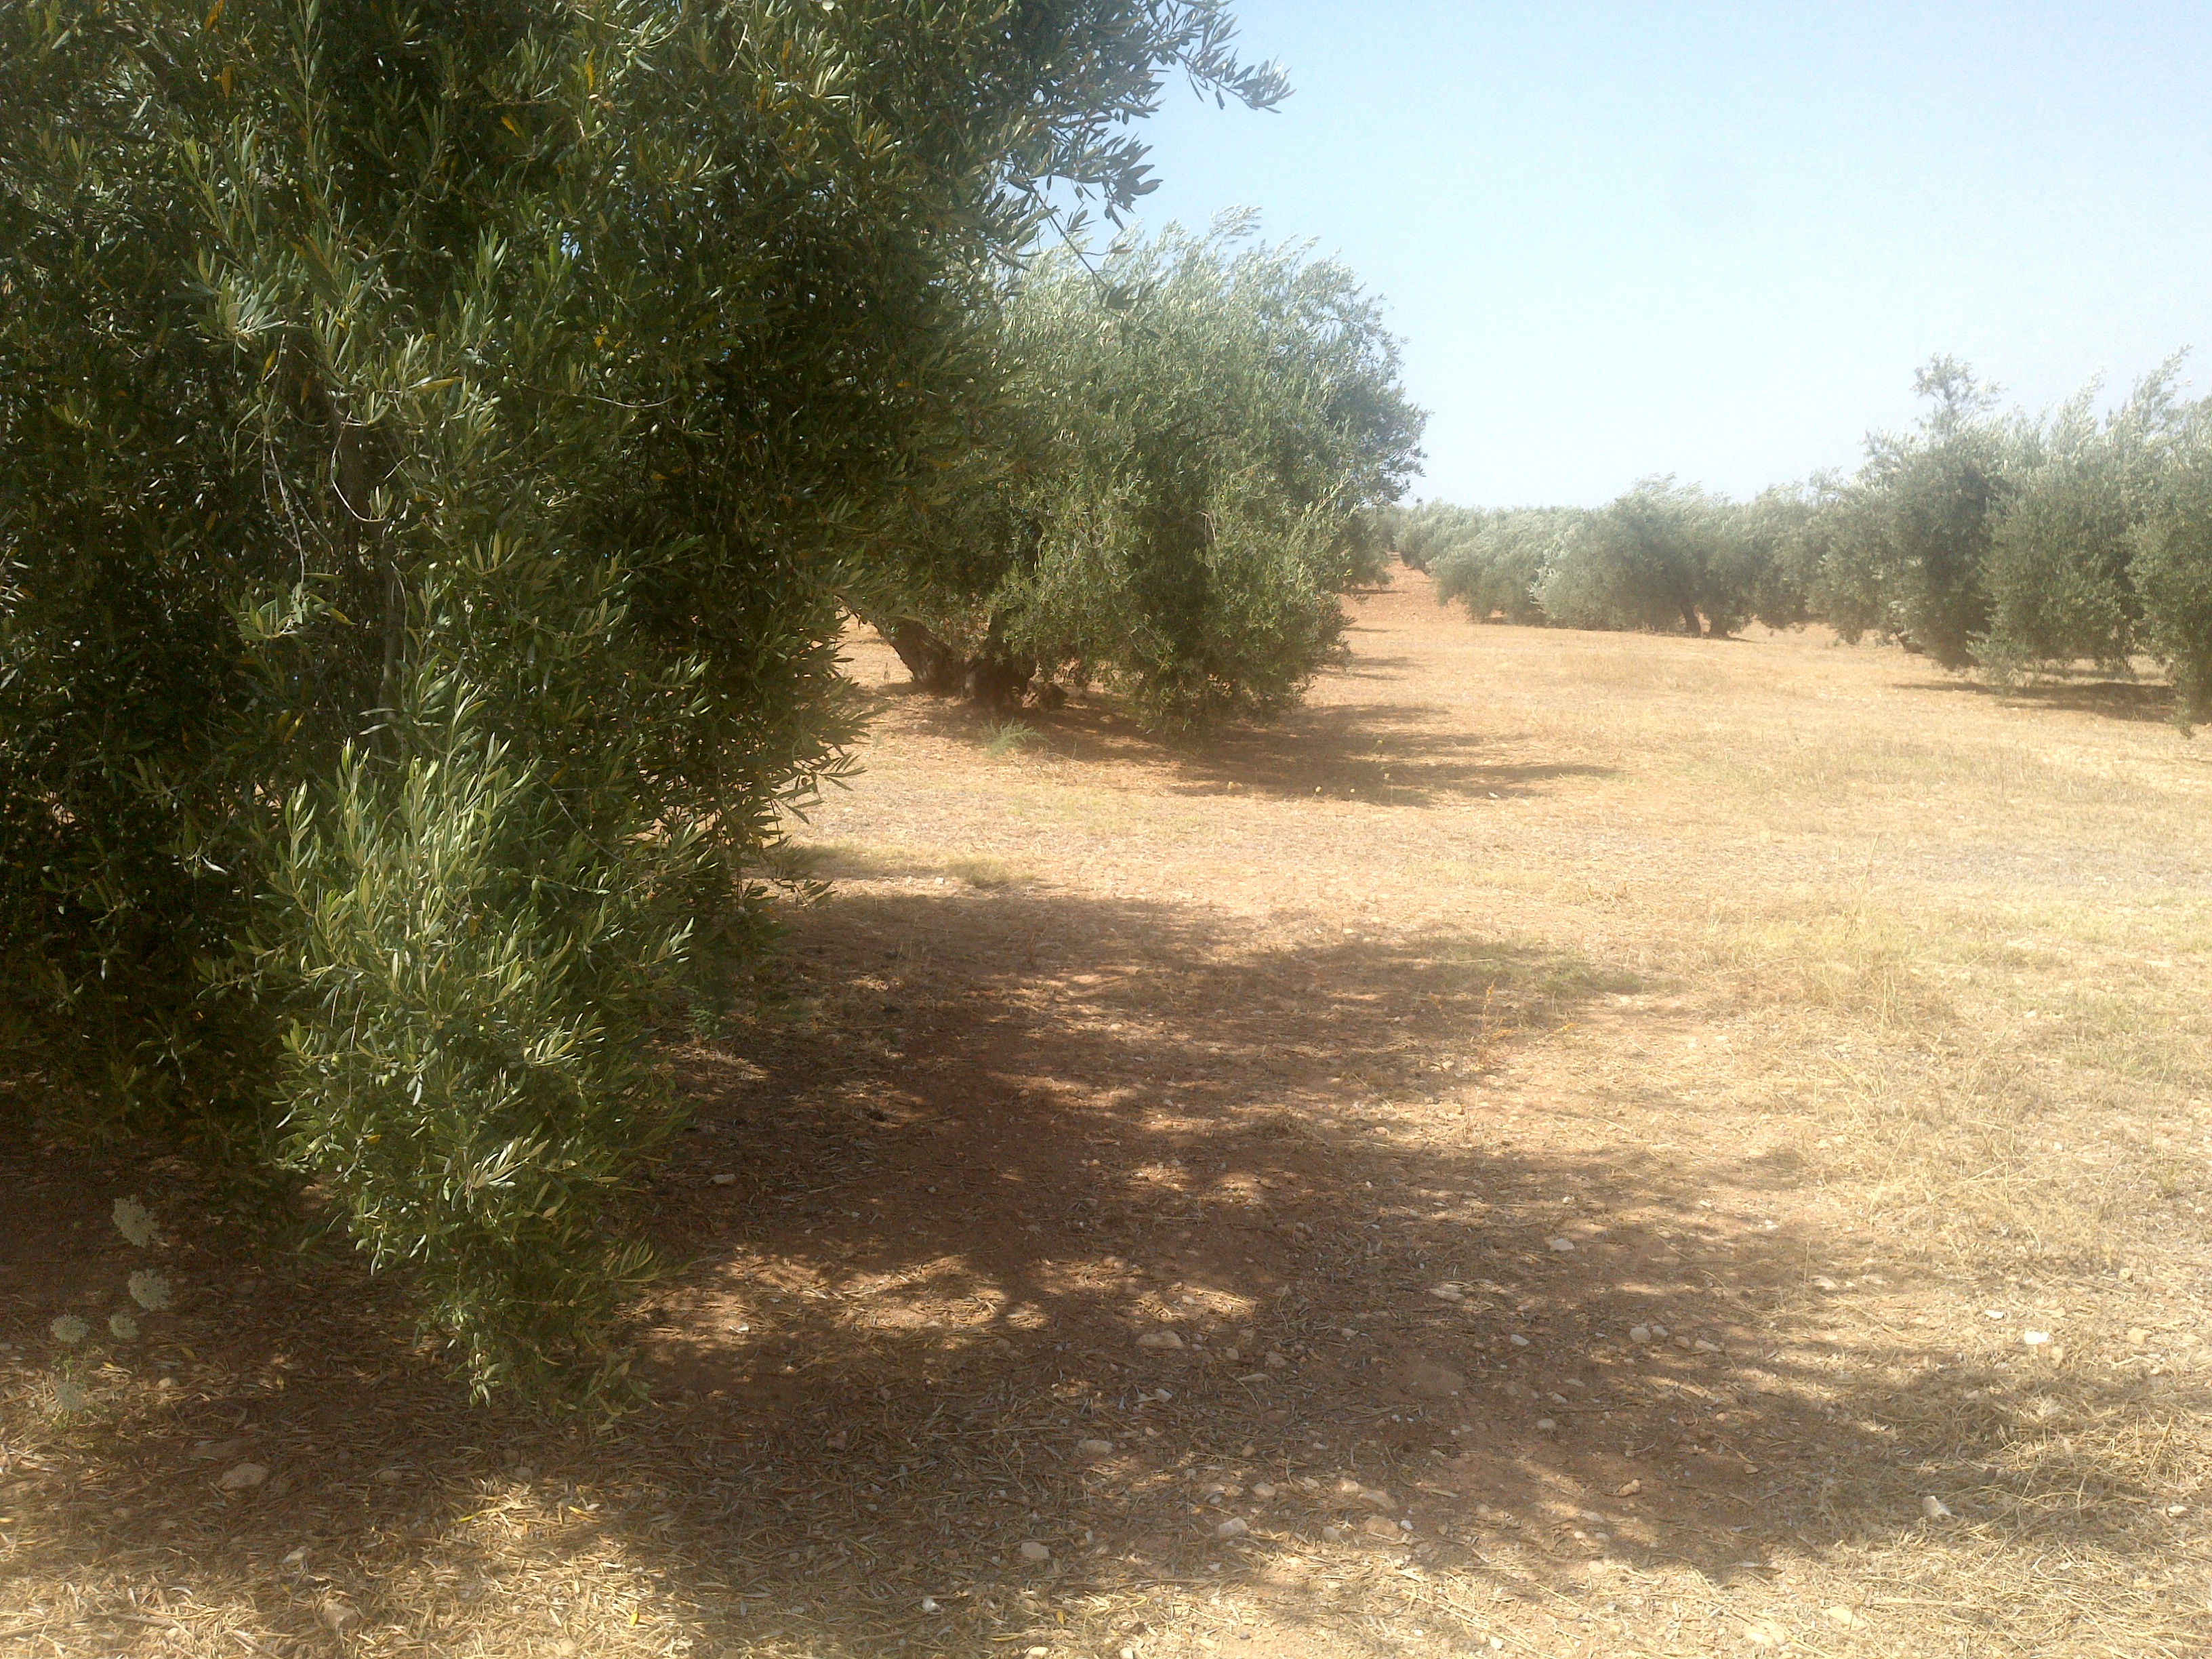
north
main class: Cropland
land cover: Olive groves
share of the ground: 25 - 50 %
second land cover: Spontaneously vegetated surfaces
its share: 10 - 25 %
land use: Agriculture (excluding fallow land and kitchen gardens)
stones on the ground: 25 - 50 %
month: June
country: ES
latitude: 37.5714
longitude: -4.2345
